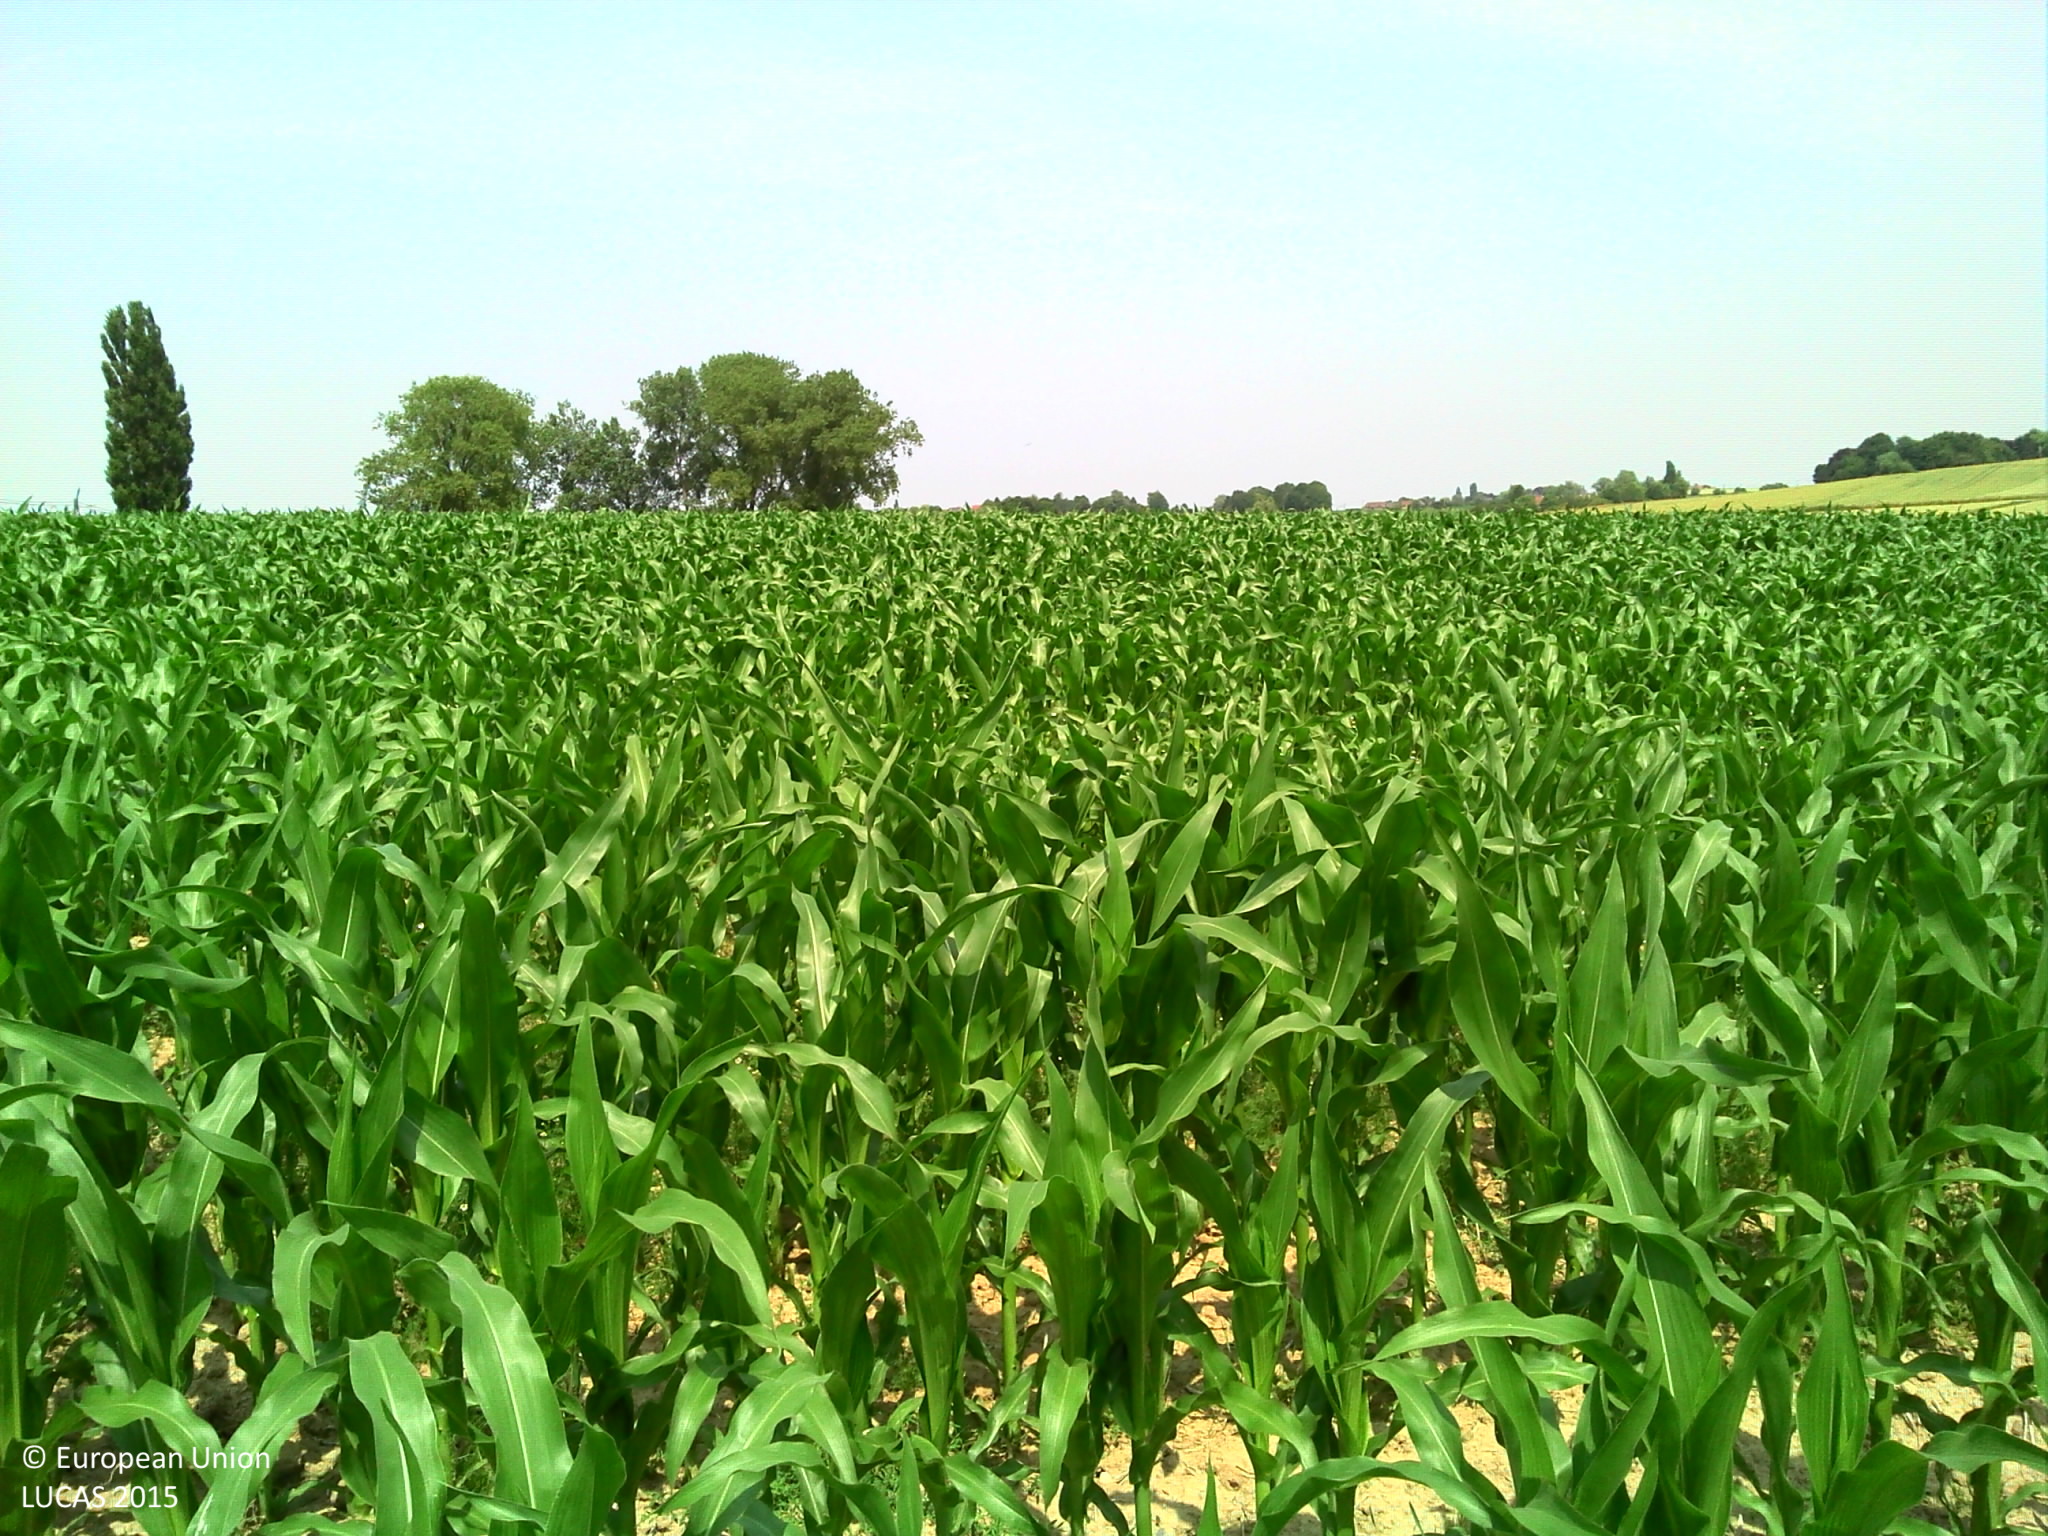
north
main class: Cropland
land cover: Common wheat
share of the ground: > 75 %
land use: Agriculture (excluding fallow land and kitchen gardens)
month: July
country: BE
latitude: 50.6287
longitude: 3.4750
